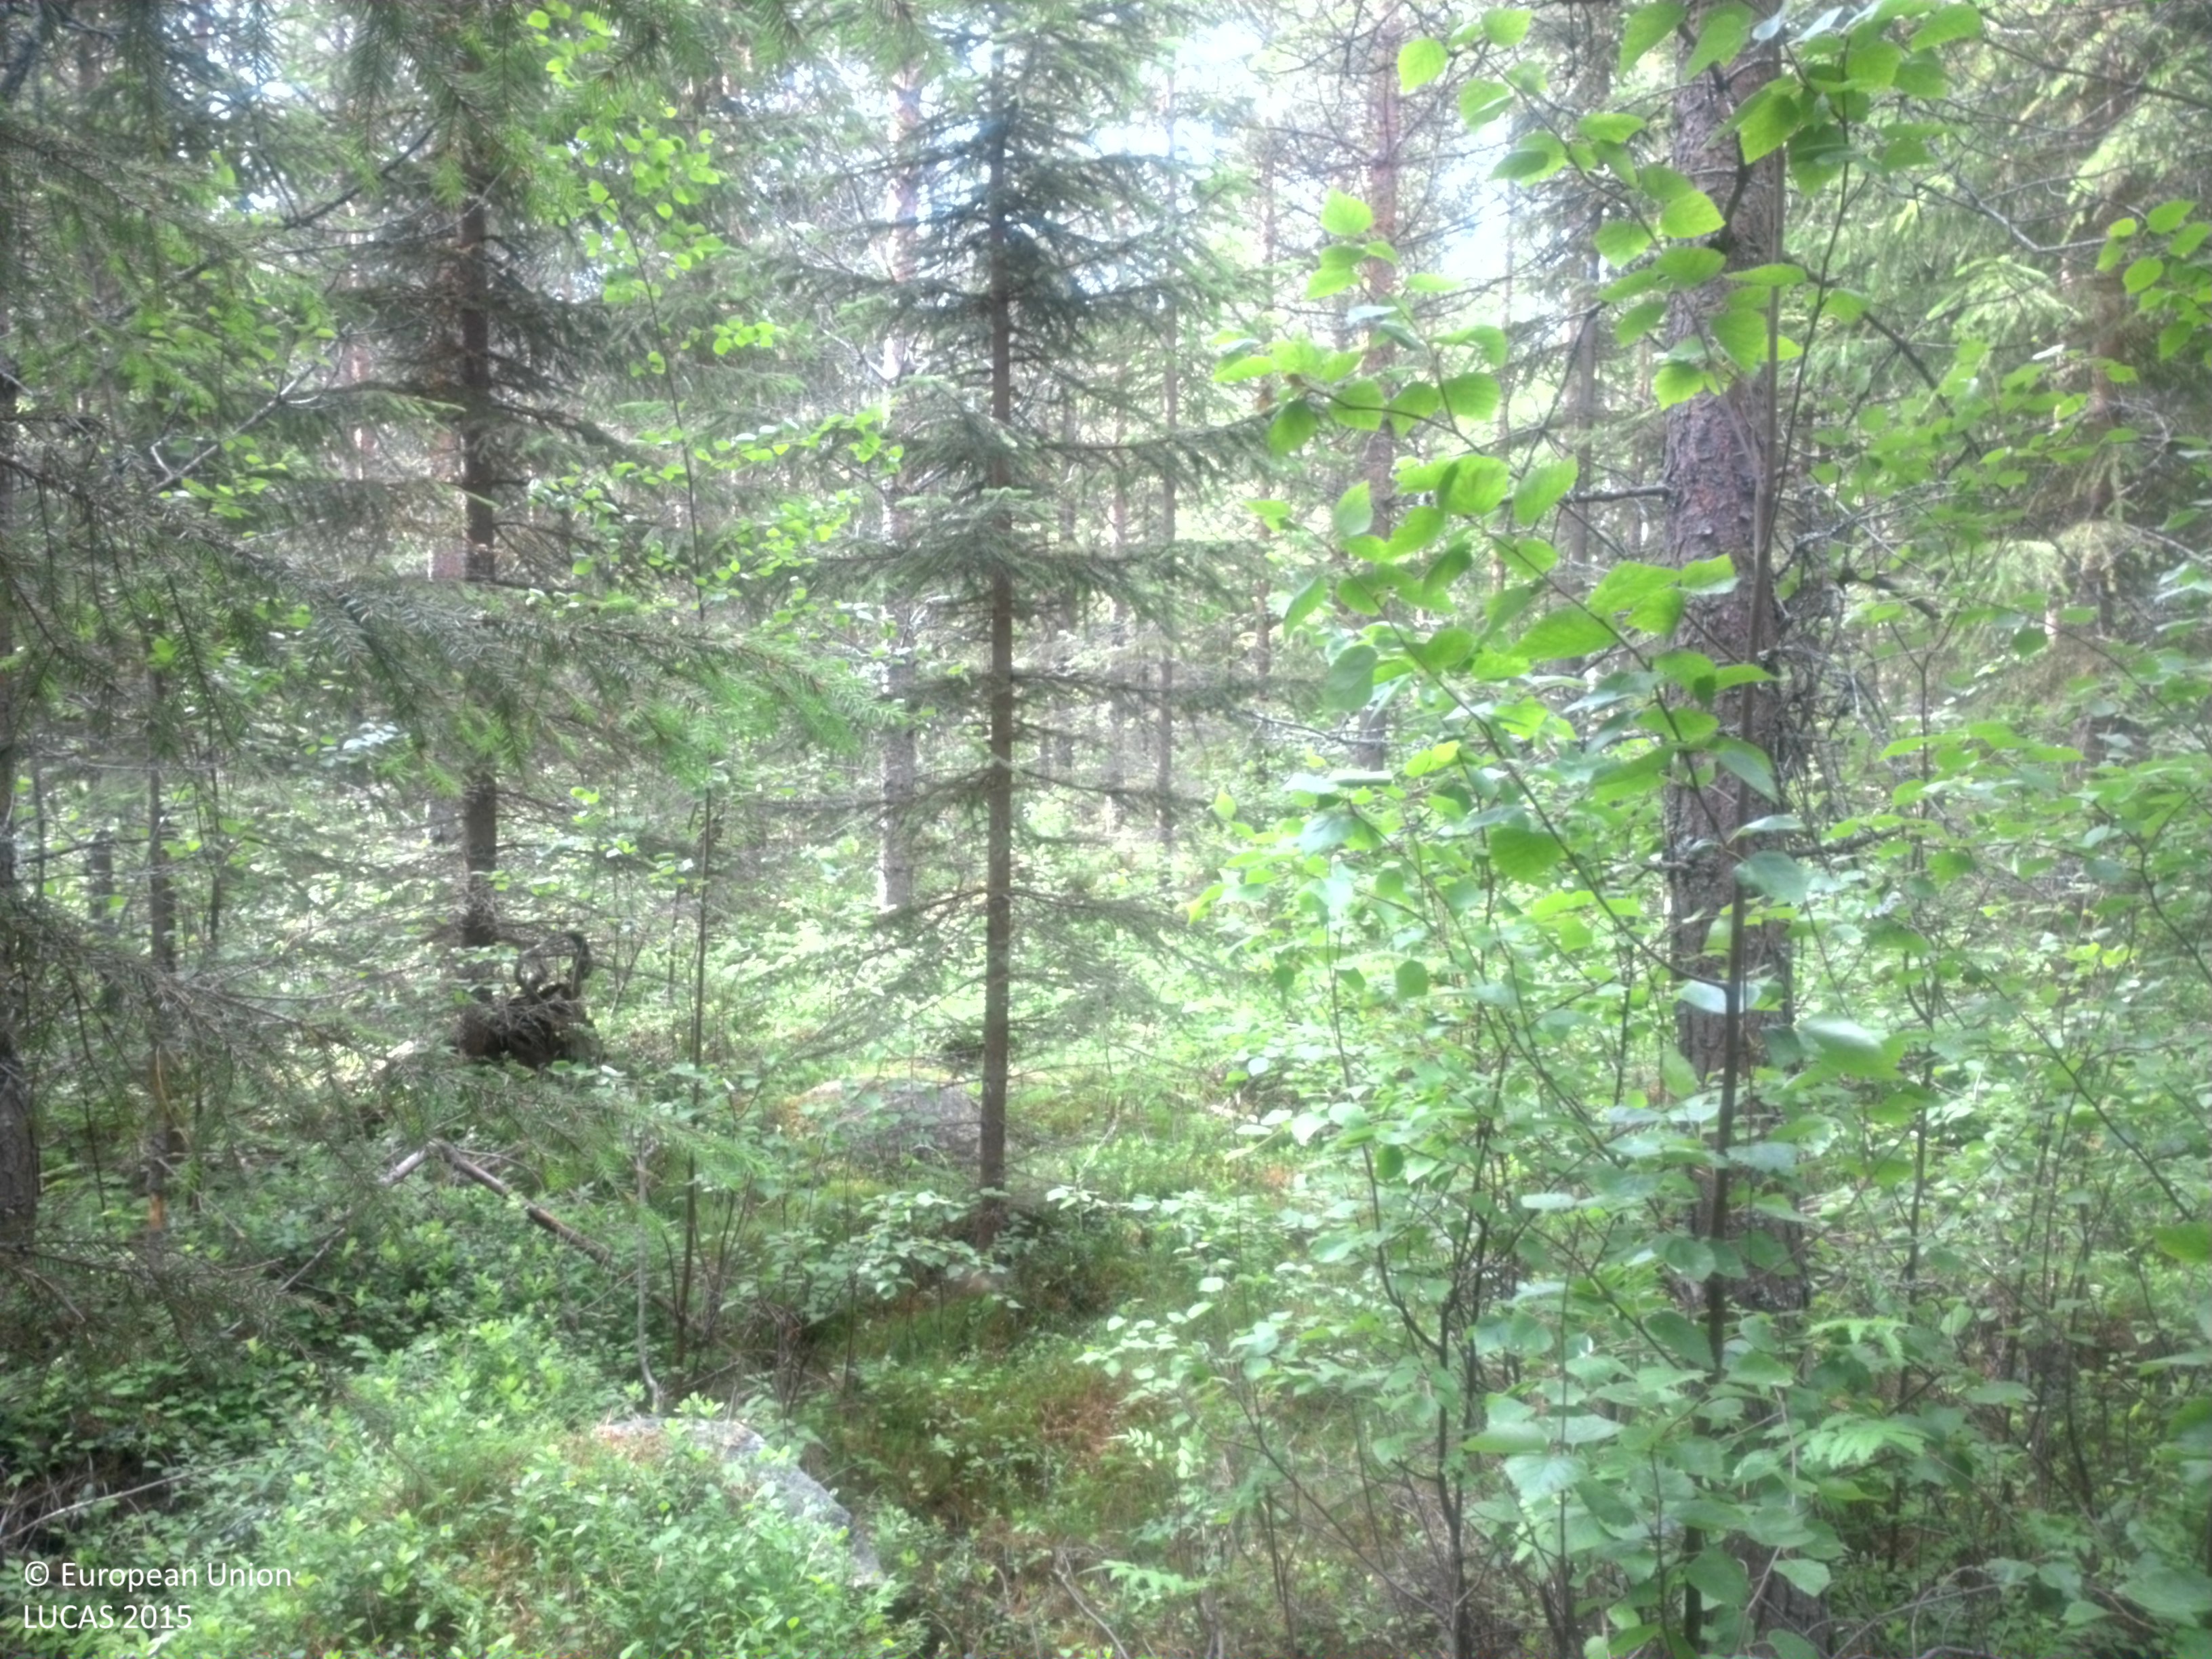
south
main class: Woodland
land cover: Other coniferous woodland
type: boreal forest
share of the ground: > 75 %
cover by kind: coniferous forest trees 80 %, shrubs 15 %, broadleaved forest trees 5 %
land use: Forestry
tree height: > 5 m
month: July
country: SE
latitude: 64.5361
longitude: 20.5880
